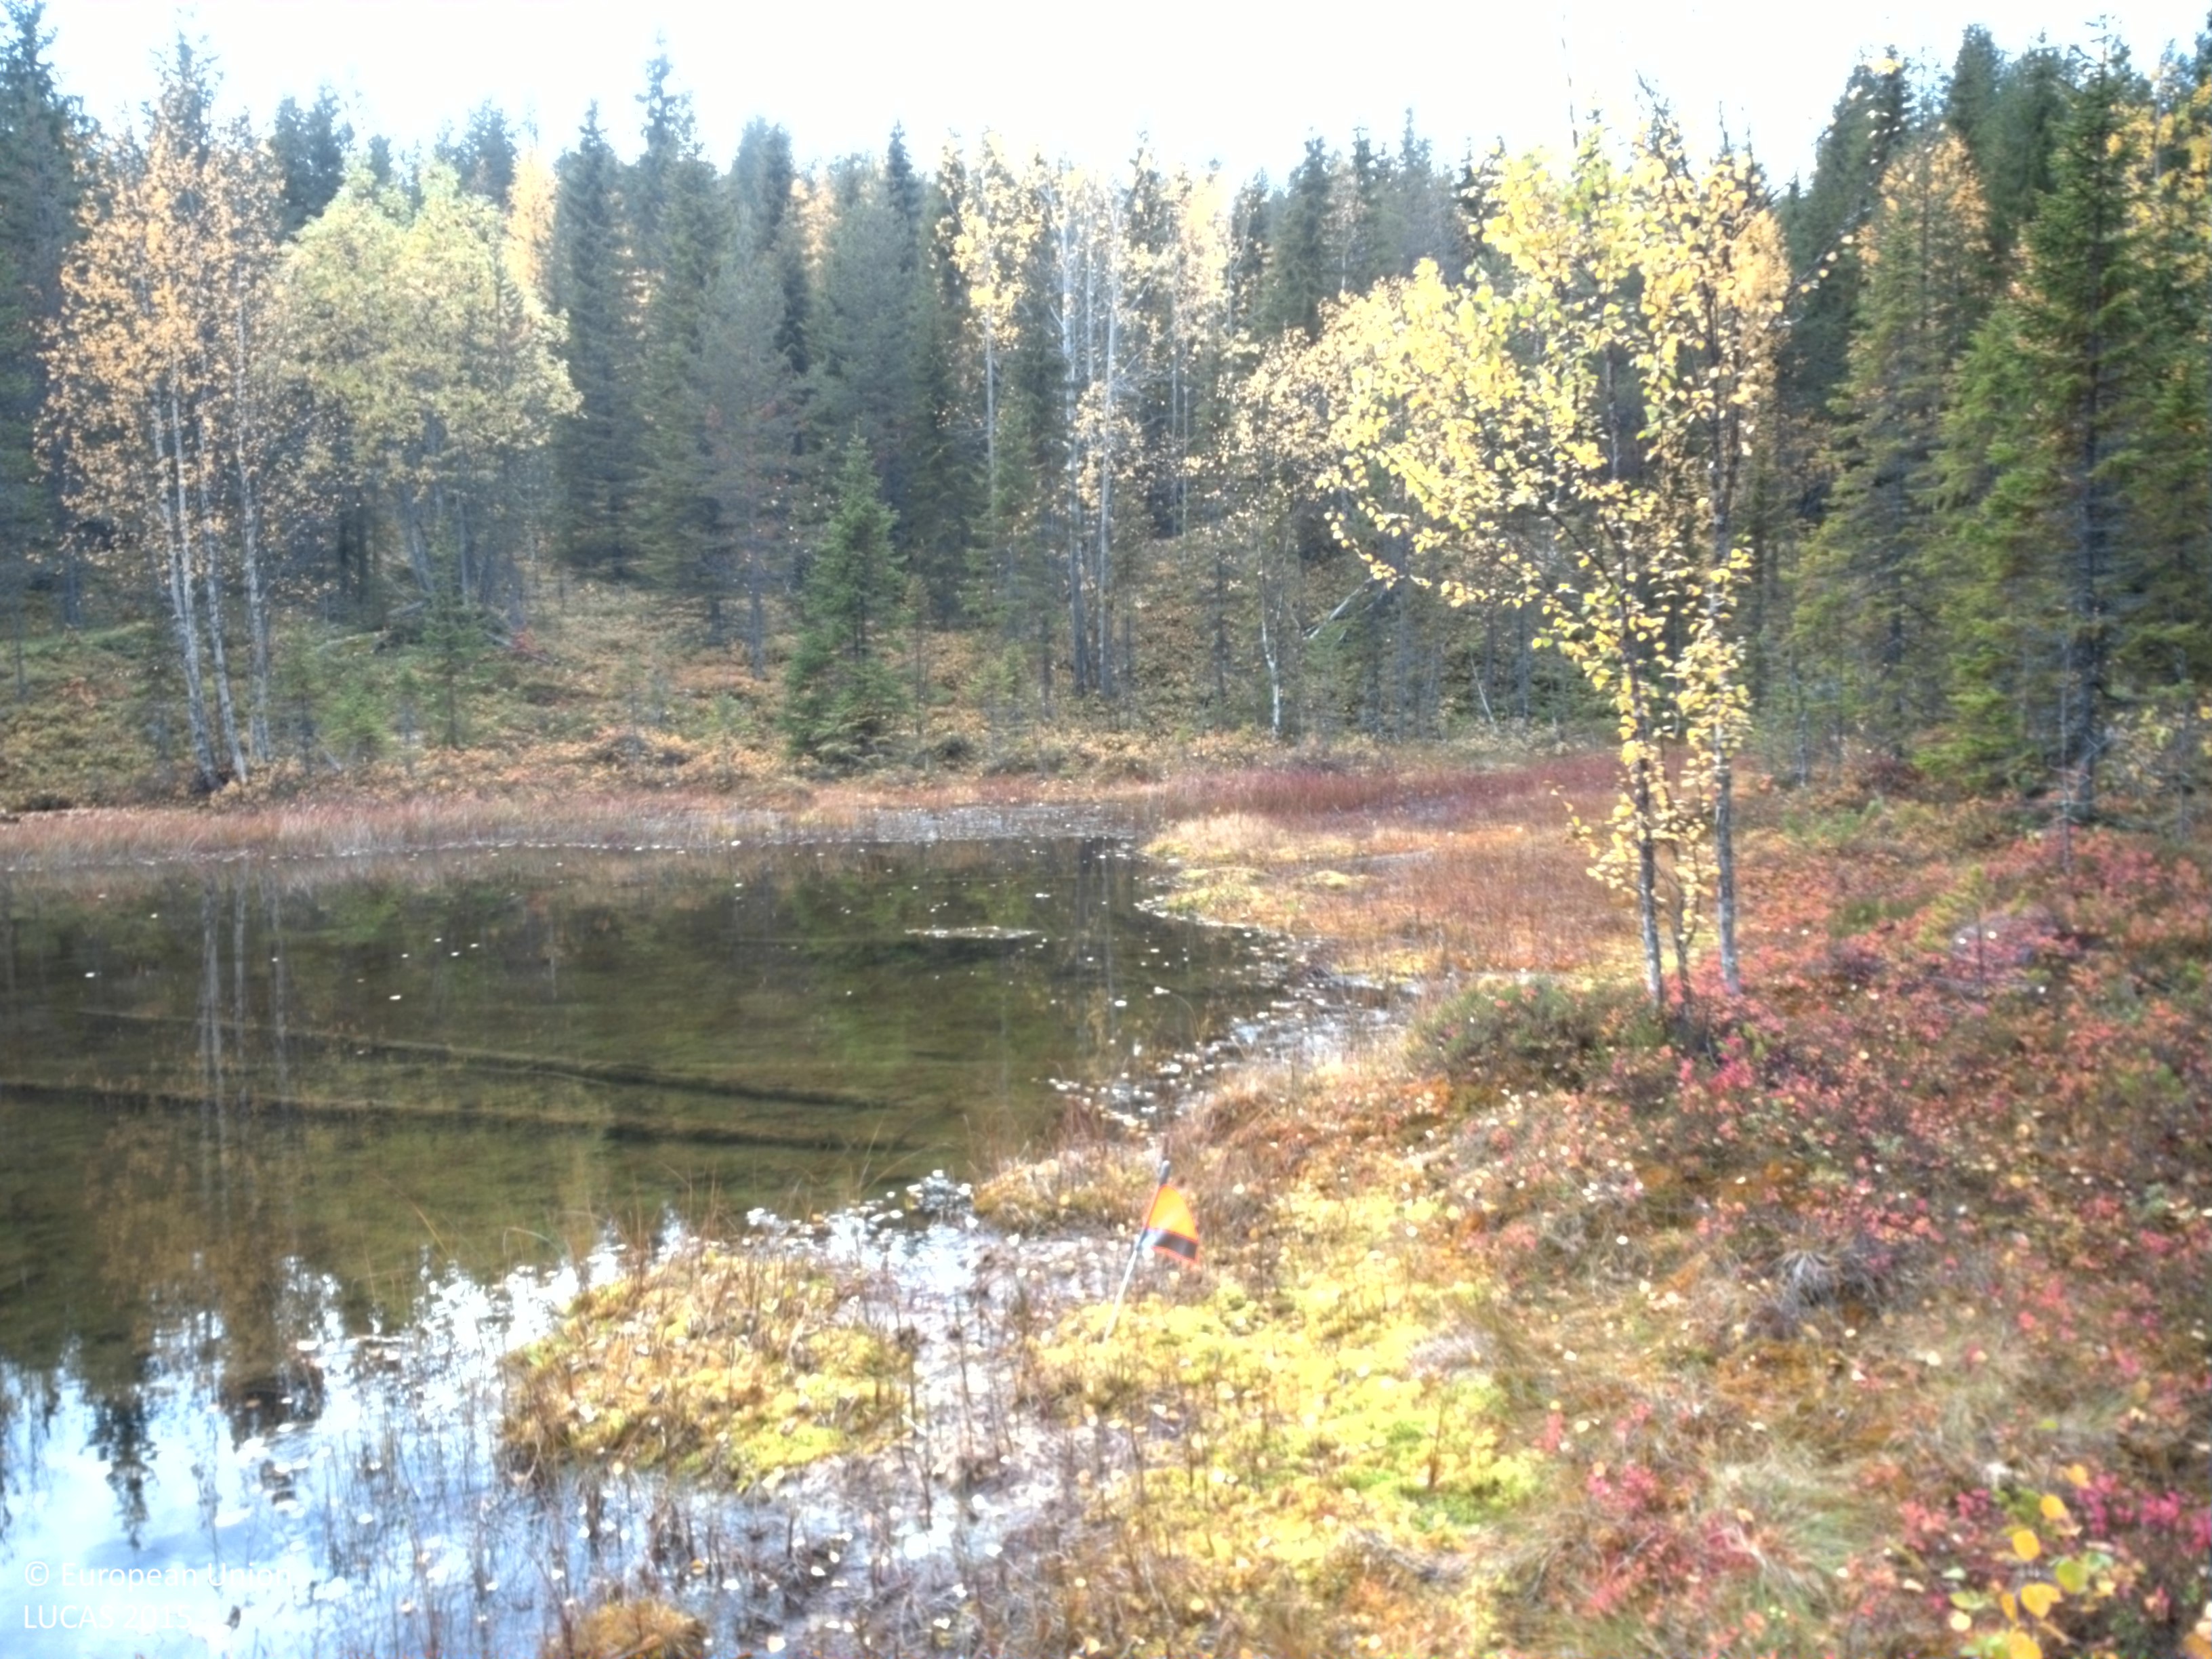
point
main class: Shrubland
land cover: Shrubland with sparse tree cover
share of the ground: 50 - 75 %
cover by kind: shrubs 70 %, lichens and mosses 15 %, herbaceous plants 10 %, broadleaved forest trees 5 %
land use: Semi-natural and natural areas not in use
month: September
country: SE
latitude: 64.8446
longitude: 17.7448
